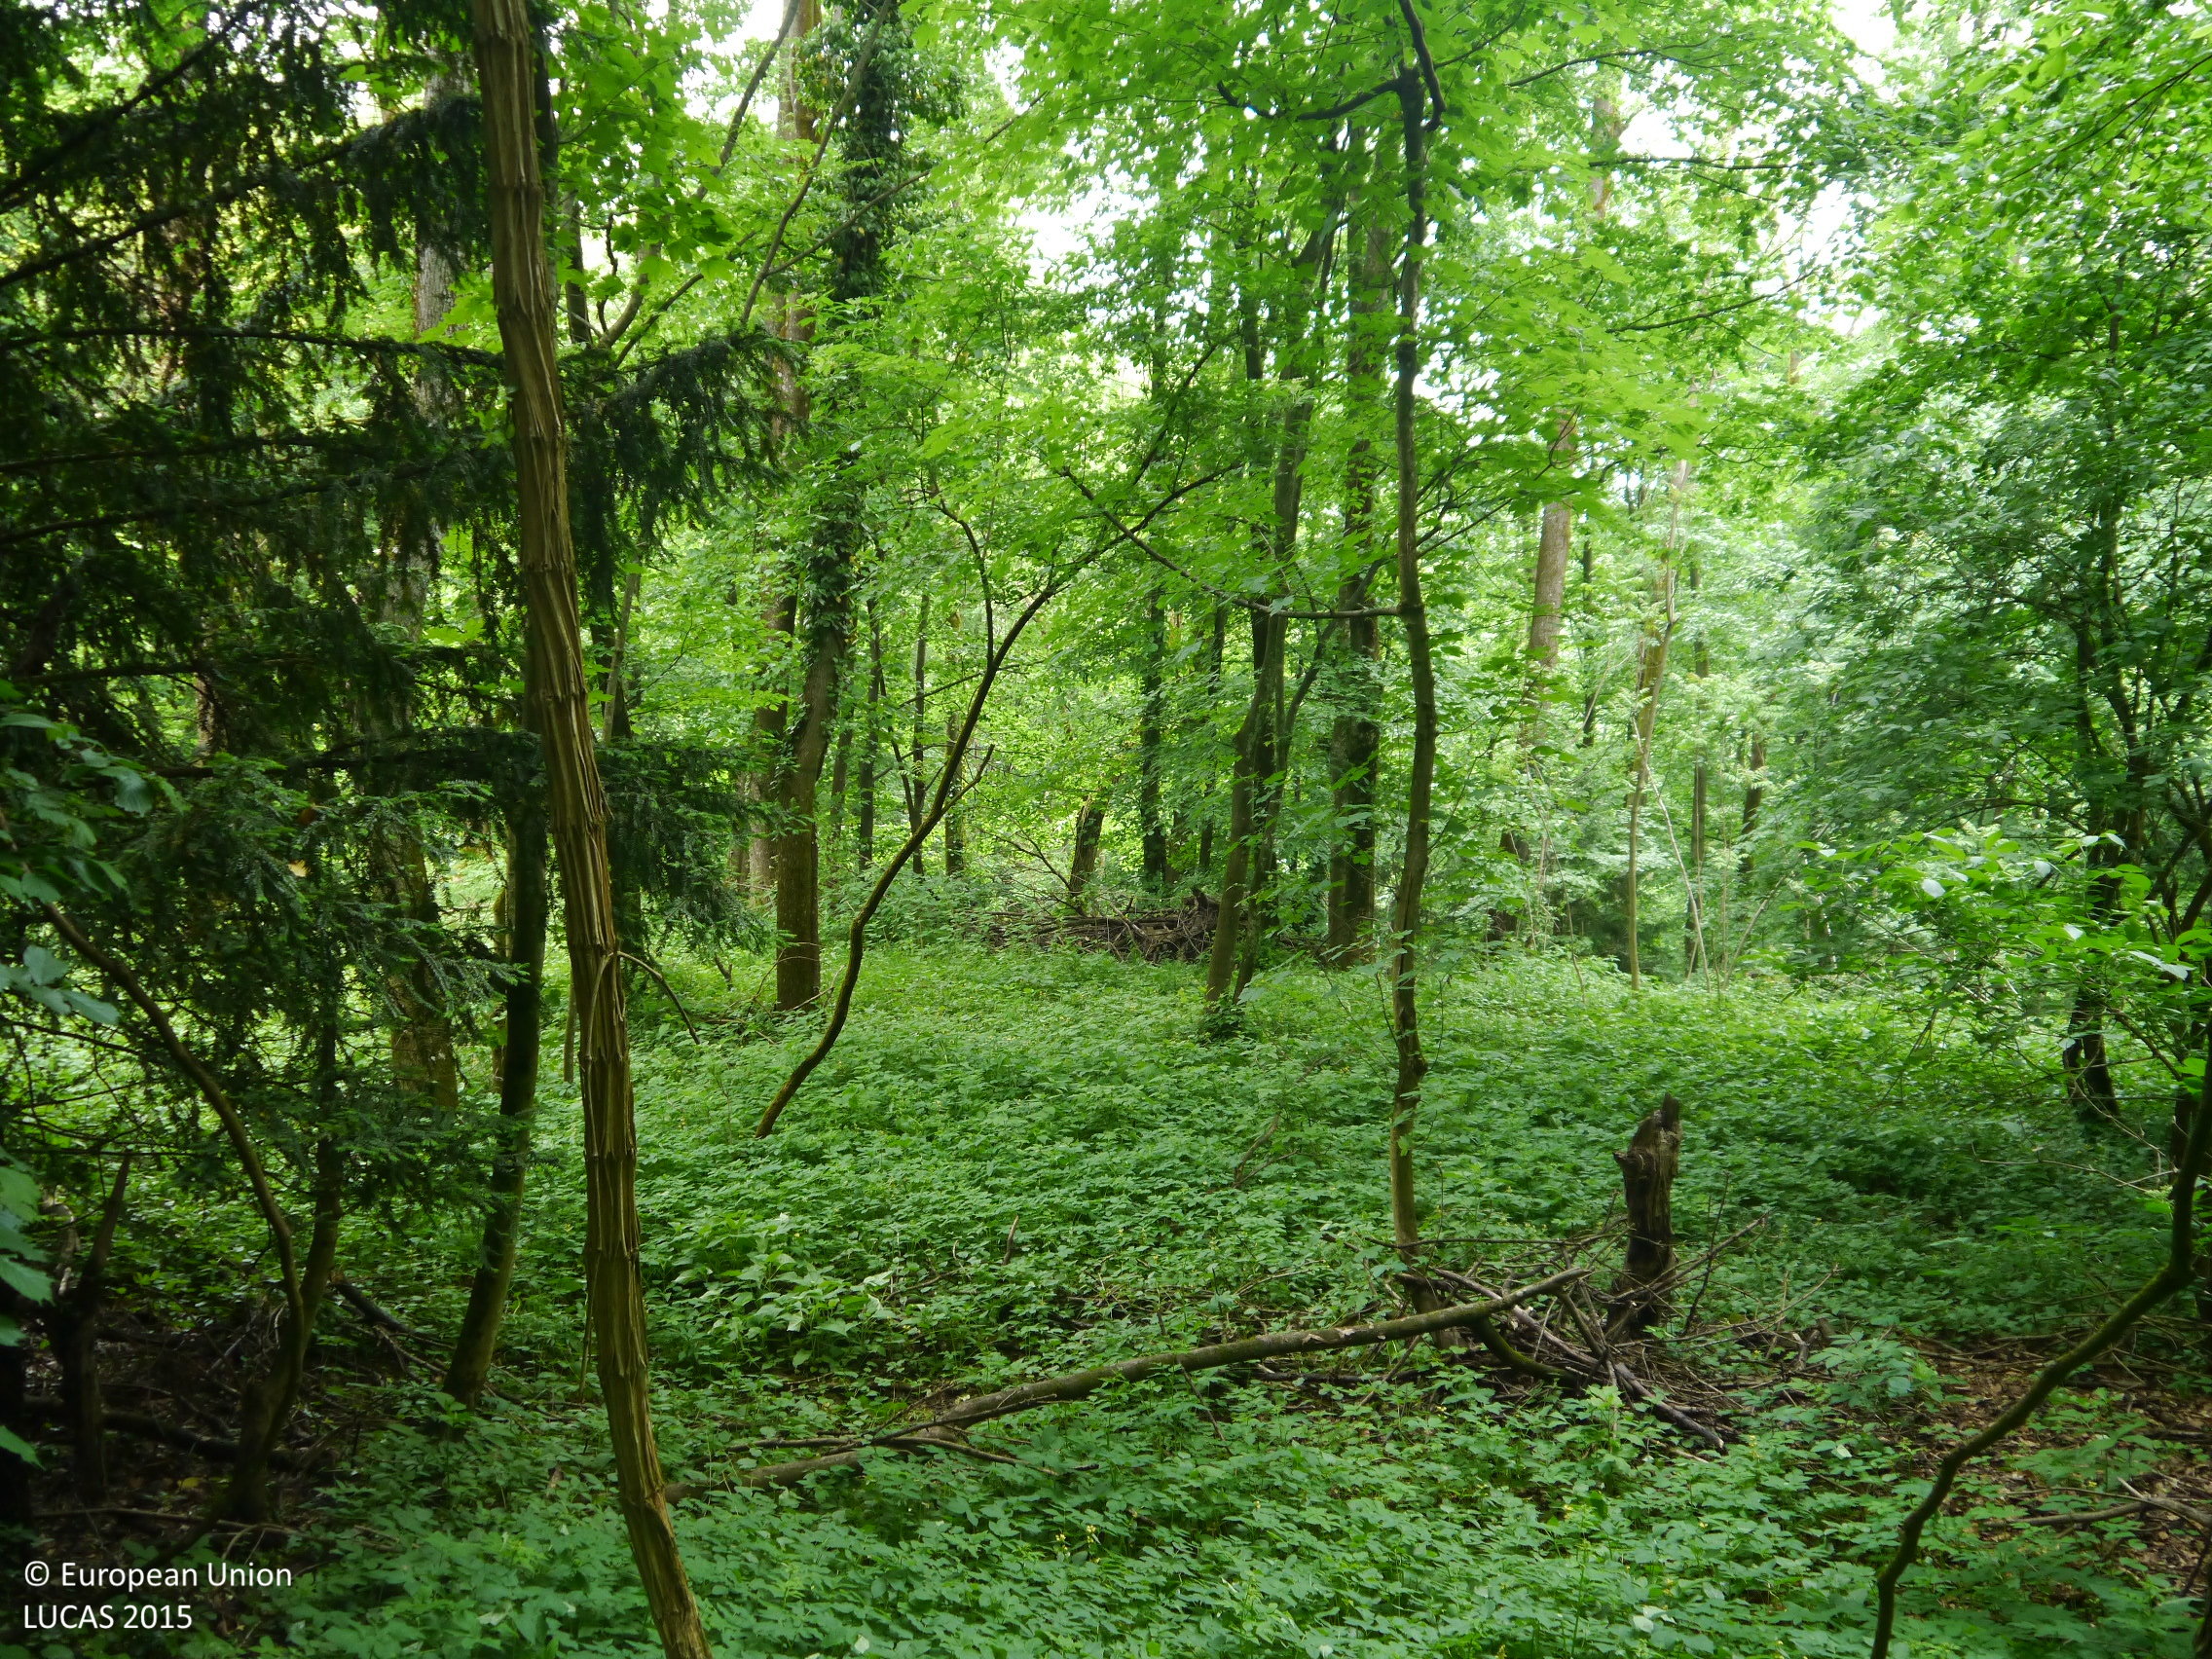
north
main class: Woodland
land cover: Broadleaved woodland
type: hemiboreal forest and nemoral coniferous forest and mixed broadleaved-coniferous forest
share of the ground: > 75 %
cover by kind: broadleaved forest trees 90 %, herbaceous plants 10 %
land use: Forestry
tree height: > 5 m
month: May
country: AT
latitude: 46.8928
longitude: 15.8936
